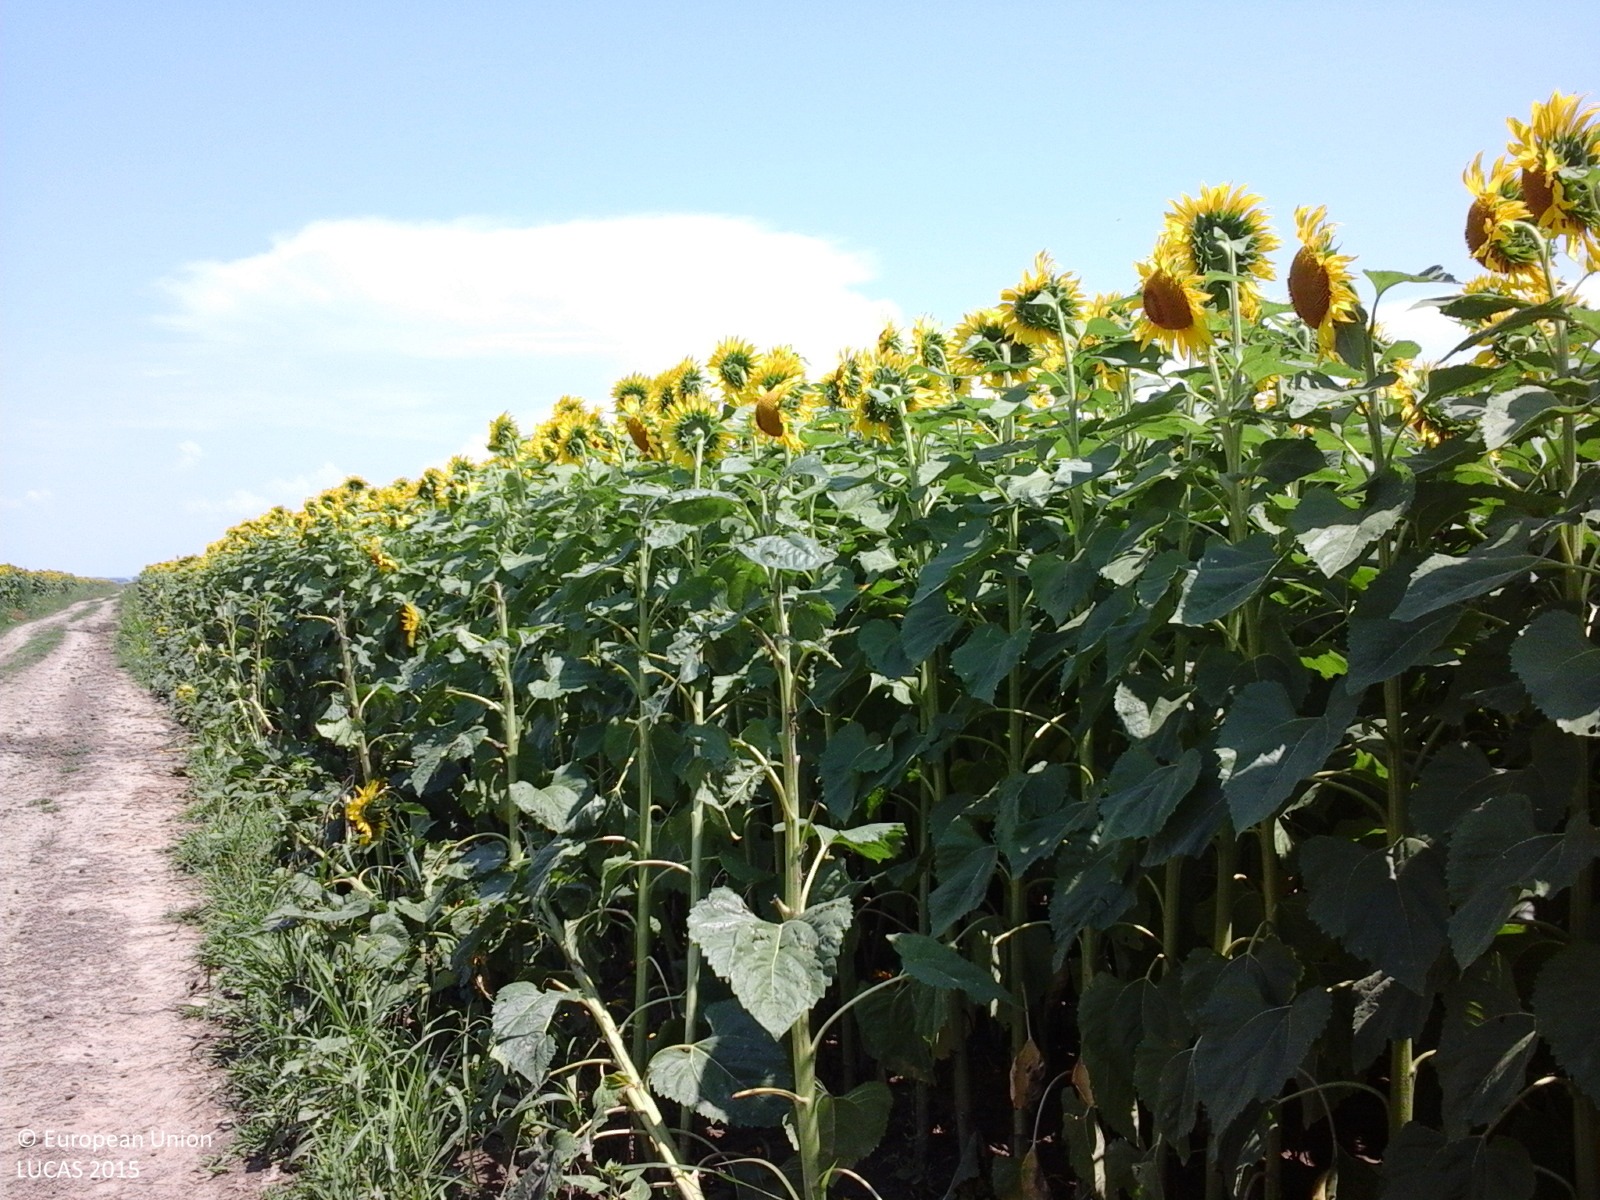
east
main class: Cropland
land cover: Sunflower
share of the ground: > 75 %
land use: Agriculture (excluding fallow land and kitchen gardens)
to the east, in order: Sunflower
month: July
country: RO
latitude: 43.6485
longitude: 25.4176
